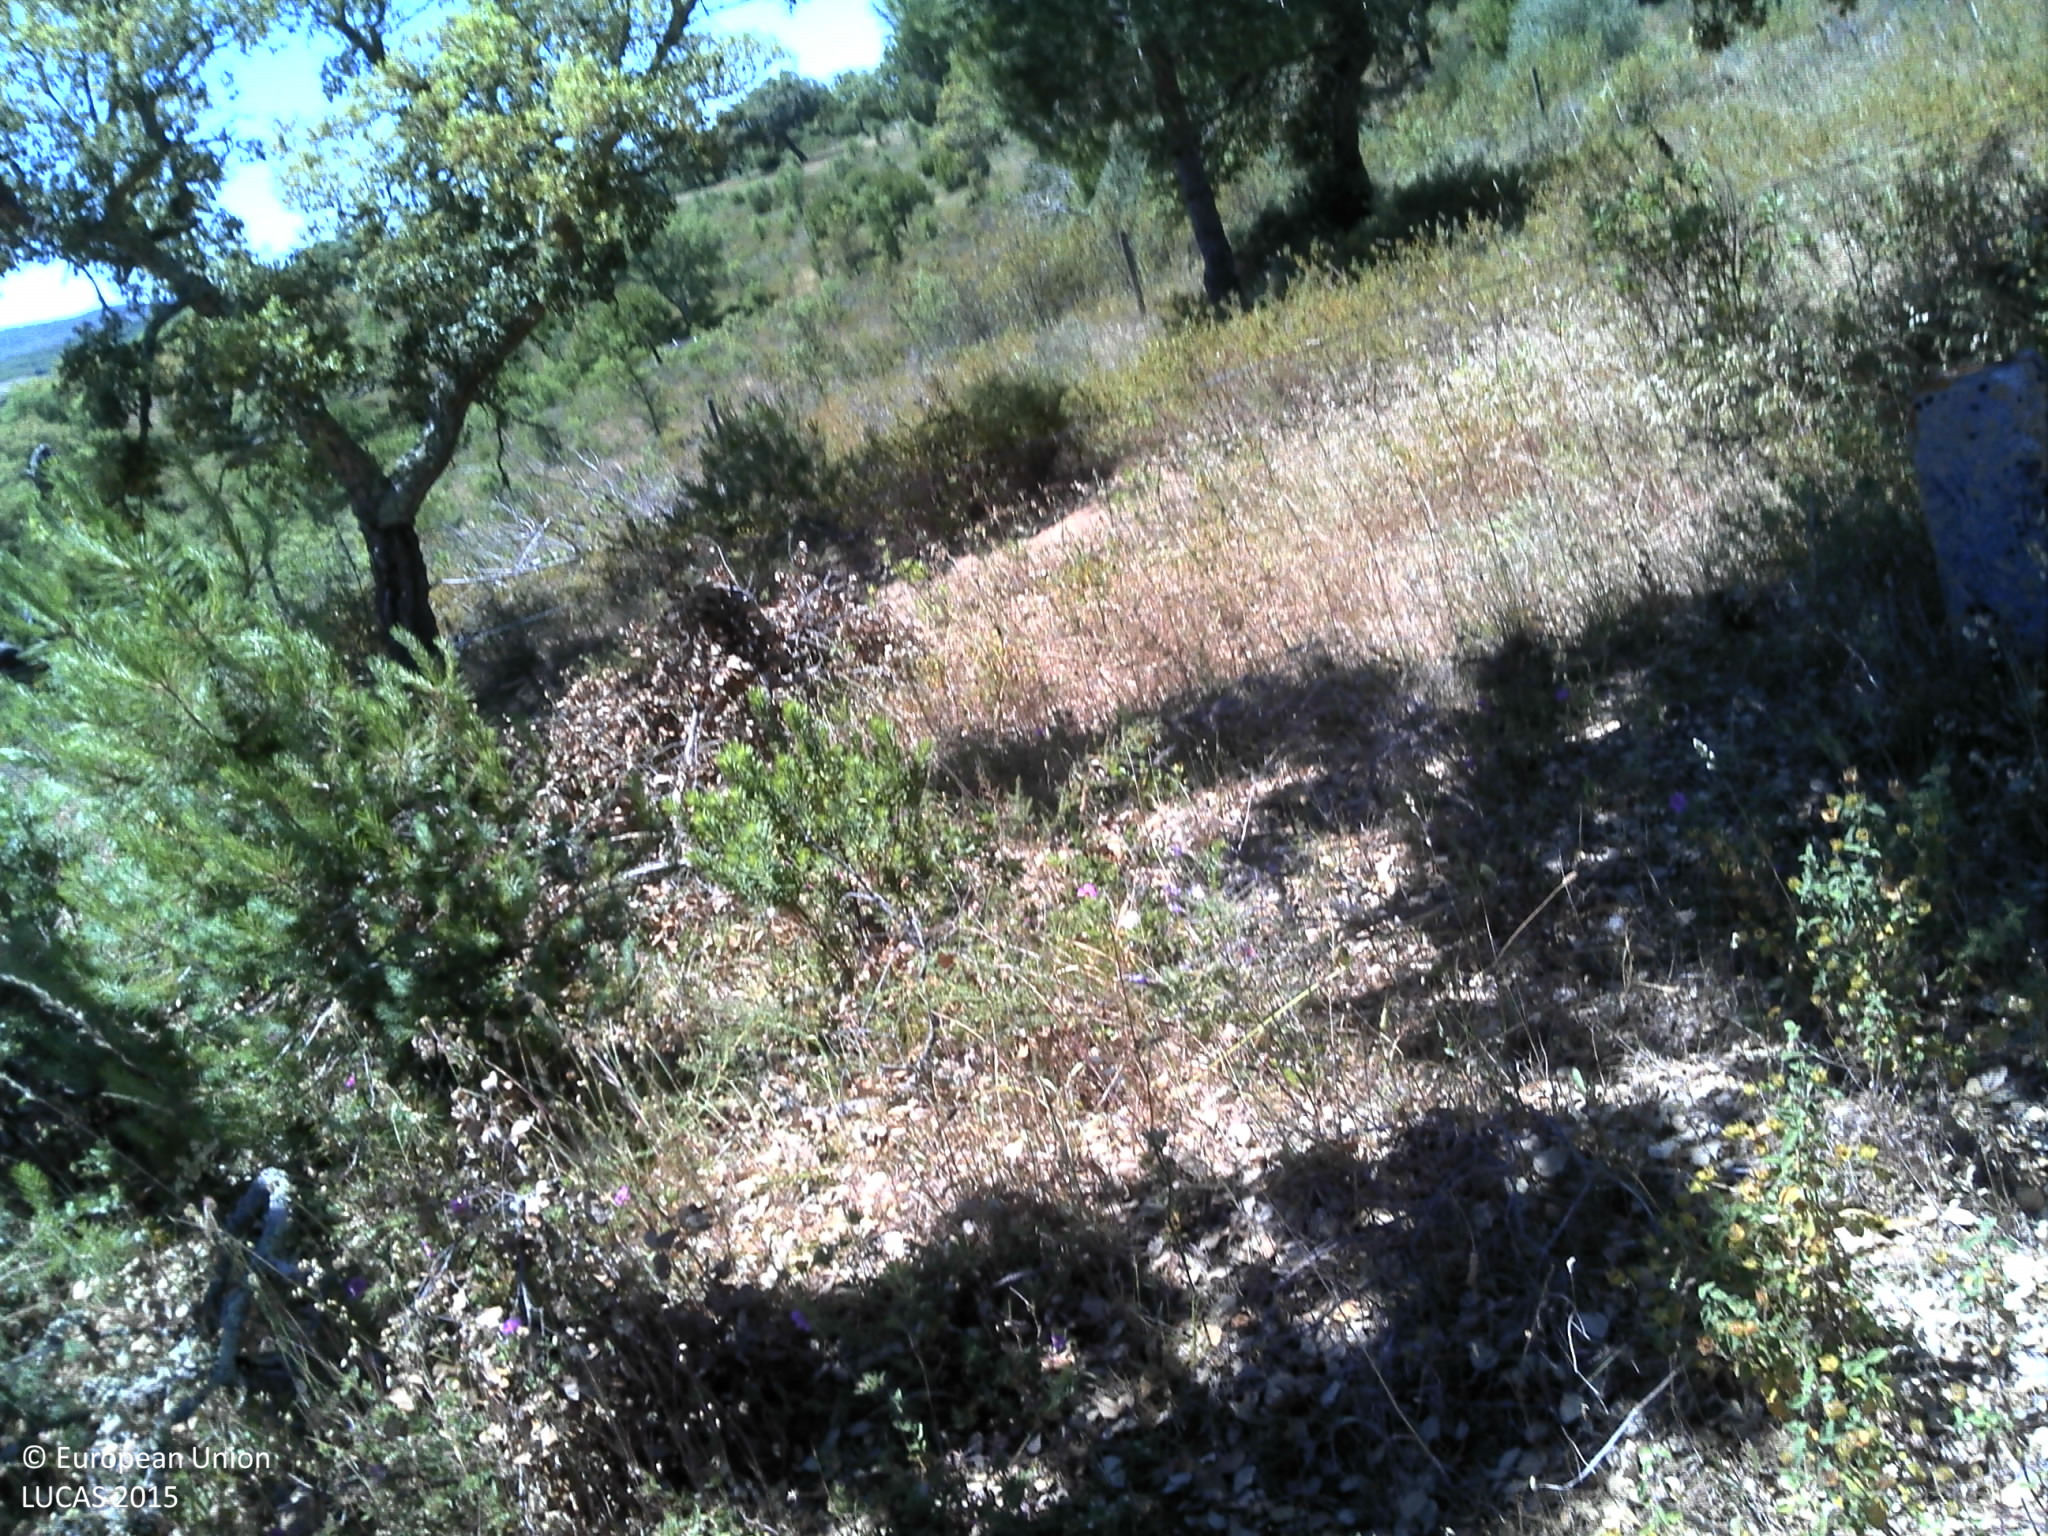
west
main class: Woodland
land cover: Broadleaved woodland
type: broadleaved evergreen forest
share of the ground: 25 - 50 %
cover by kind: herbaceous plants 55 %, broadleaved forest trees 30 %, unconsolidated bare surface 15 %
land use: Forestry
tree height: > 5 m
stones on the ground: < 10 %
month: May
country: PT
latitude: 38.5343
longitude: -8.4651
